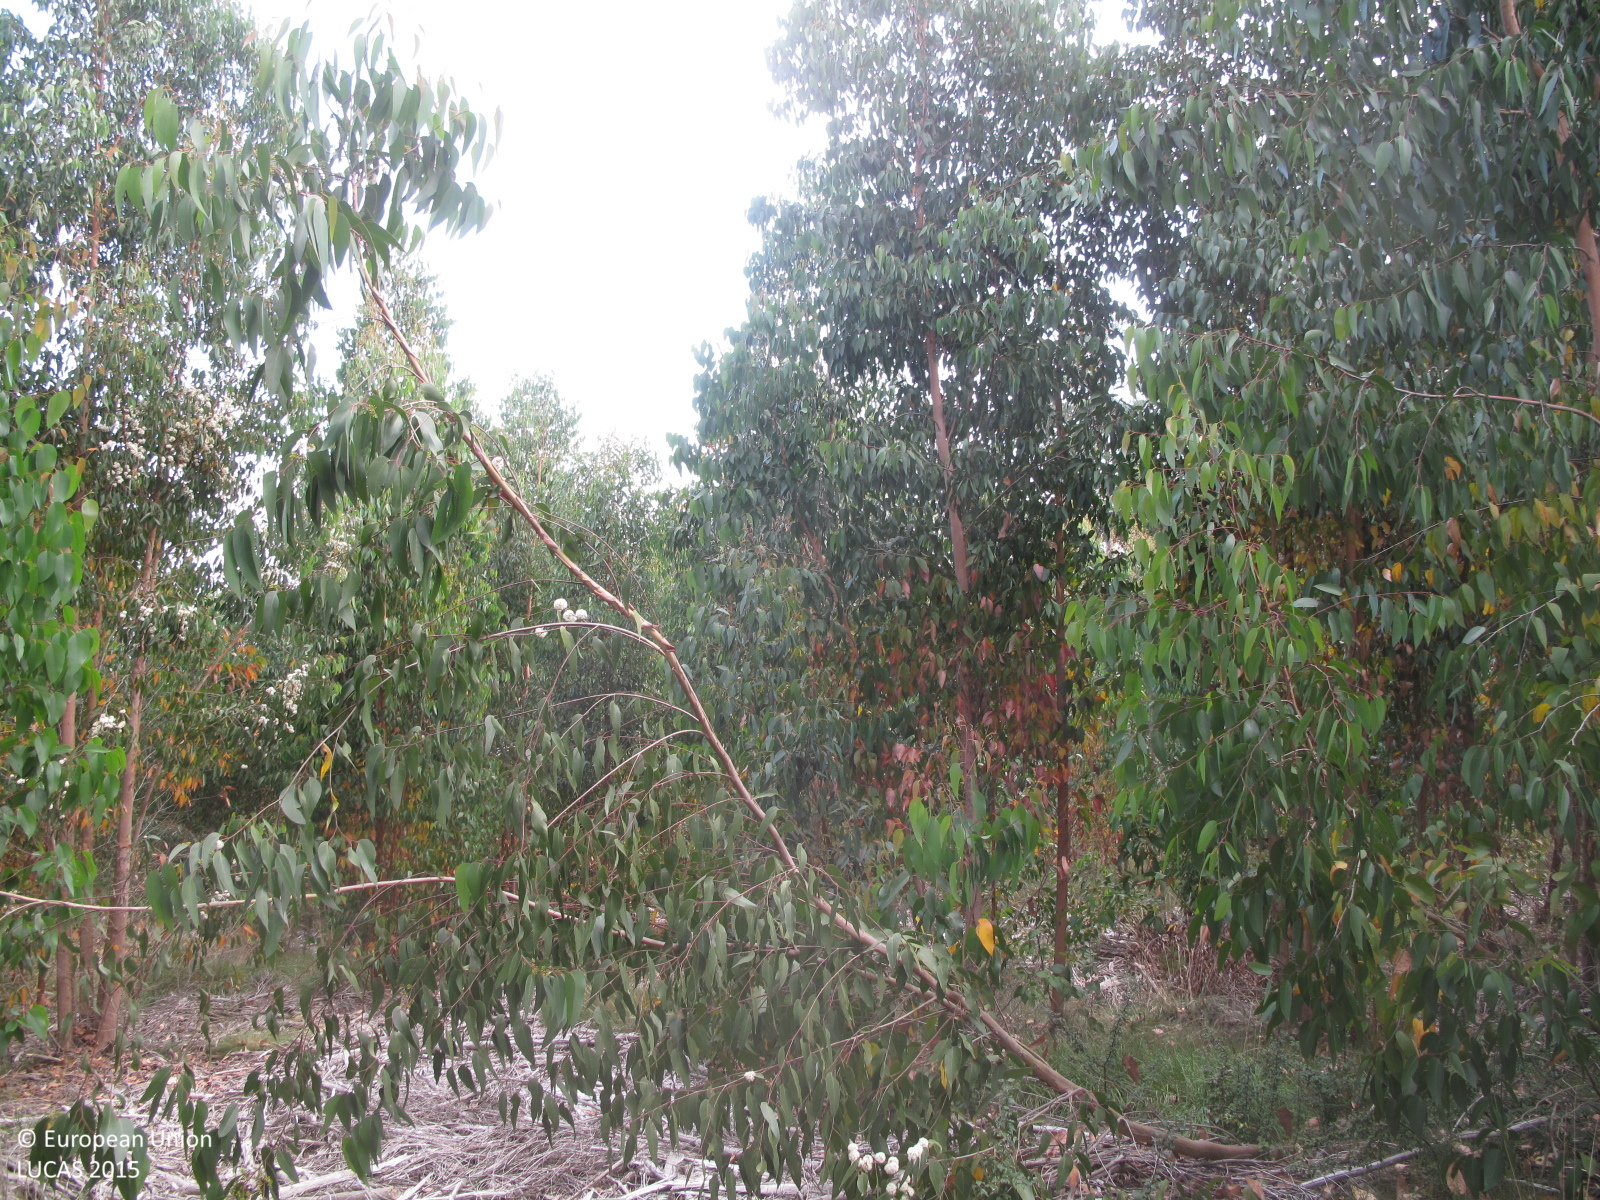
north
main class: Woodland
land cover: Broadleaved woodland
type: exotic forest
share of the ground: 50 - 75 %
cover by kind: broadleaved forest trees 60 %, unconsolidated bare surface 20 %, shrubs 10 %, herbaceous plants 10 %
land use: Forestry
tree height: > 5 m
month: July
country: ES
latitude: 43.2951
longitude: -8.1048
